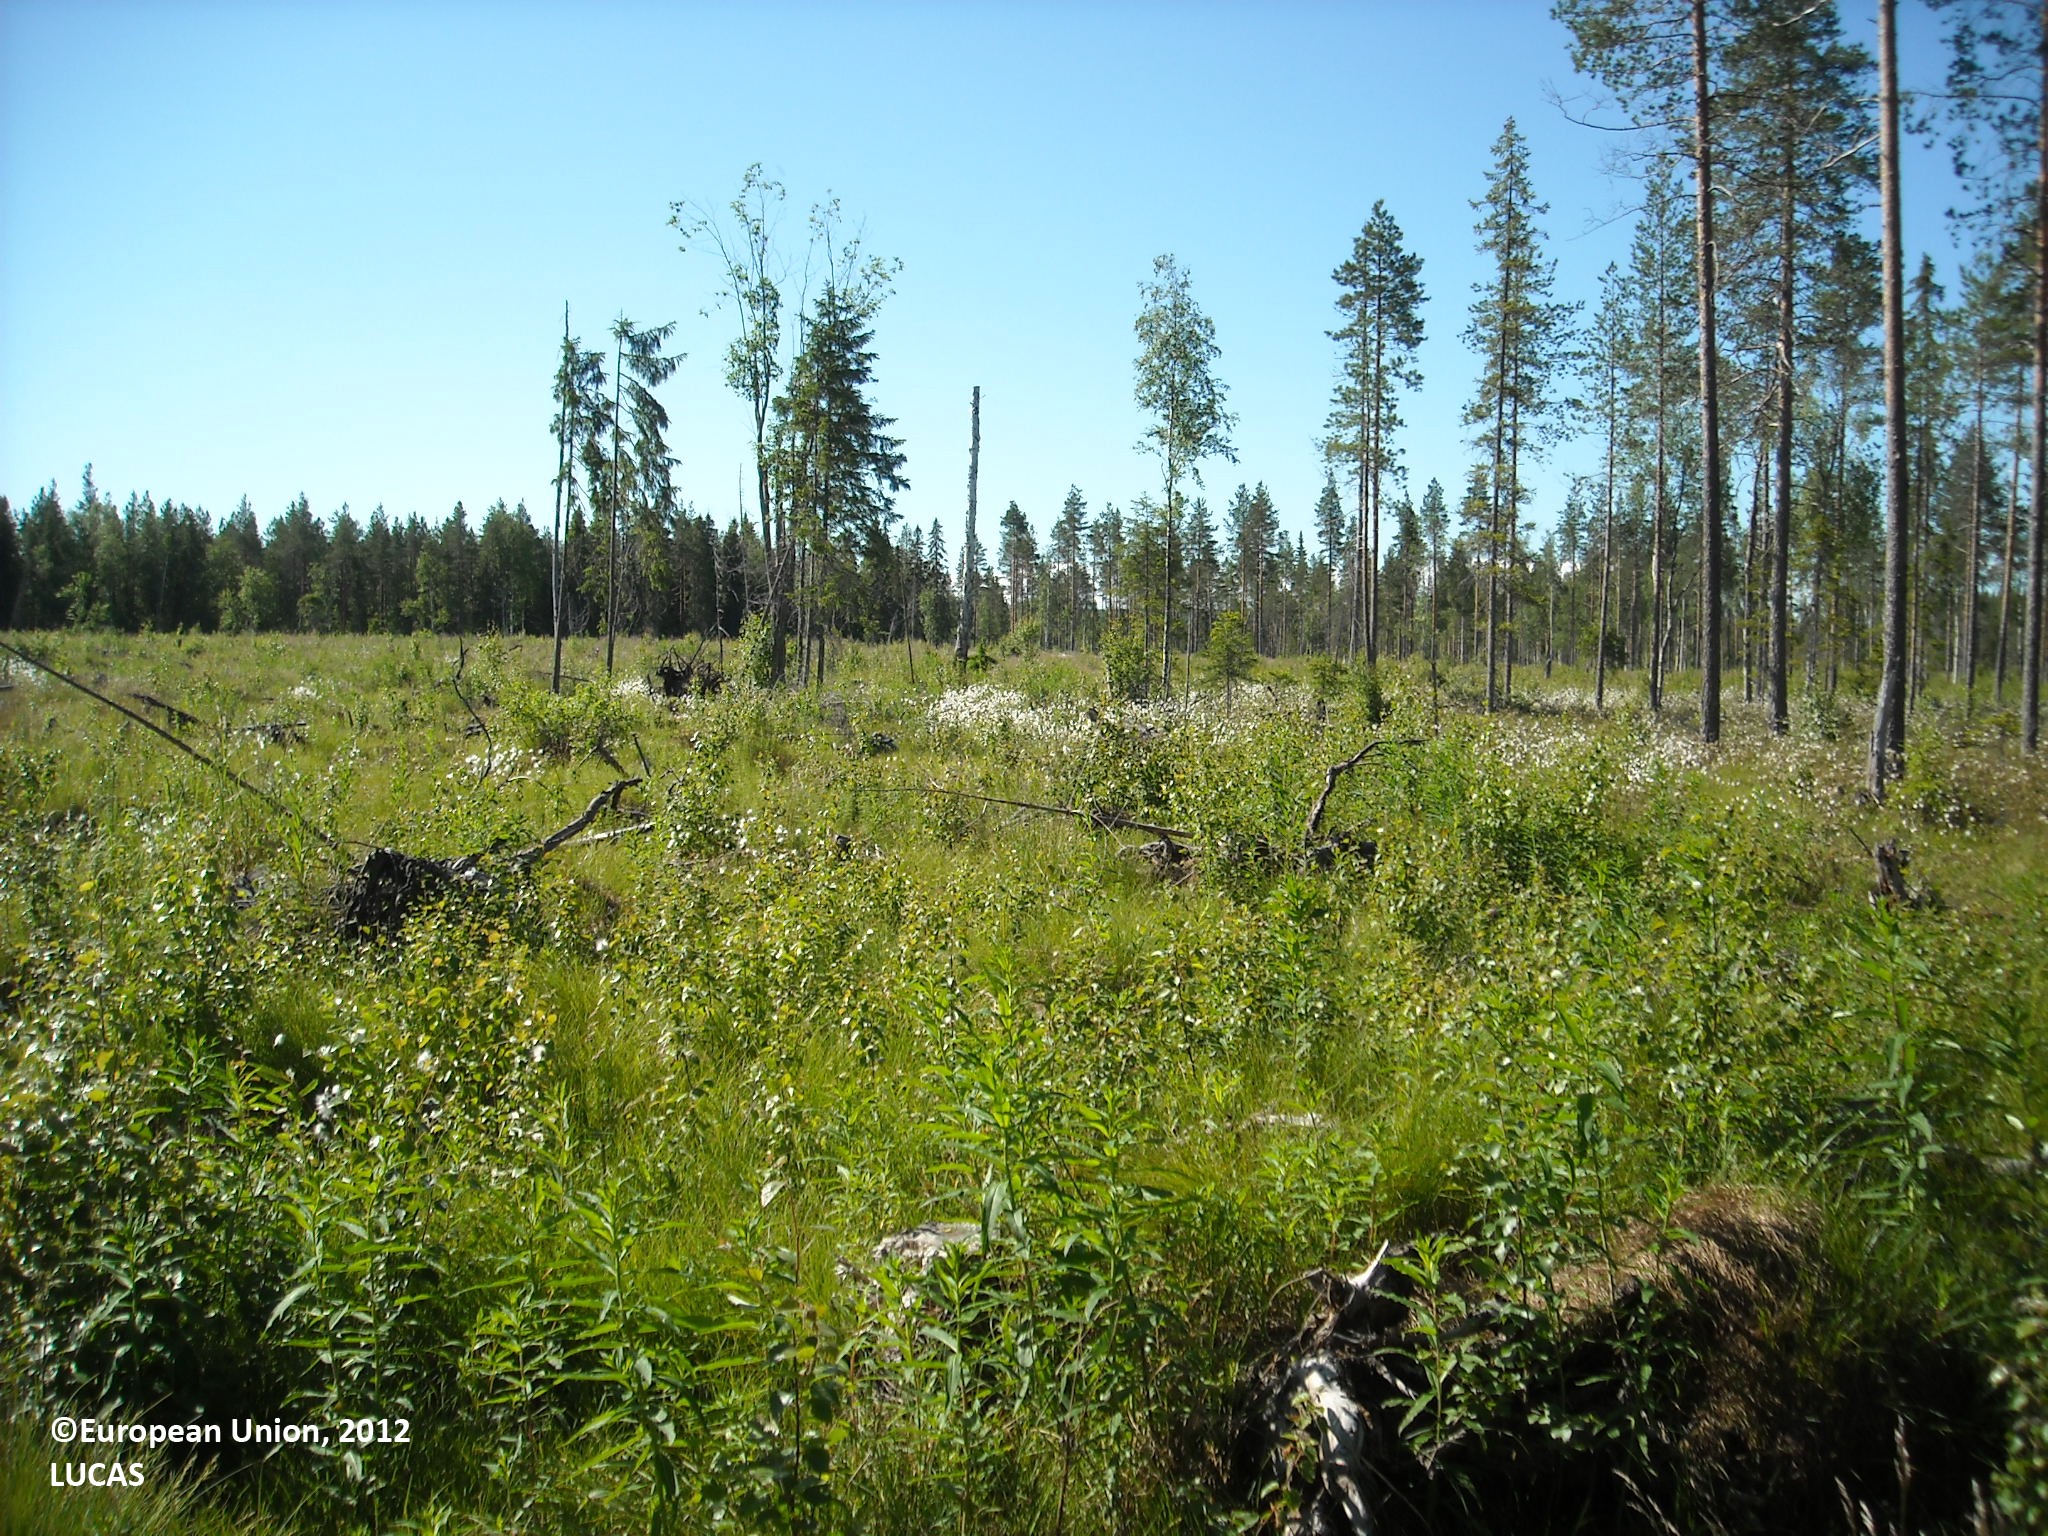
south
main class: Woodland
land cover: Pine dominated coniferous woodland
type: boreal forest
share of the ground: 25 - 50 %
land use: Forestry
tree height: > 5 m
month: July
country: FI
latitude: 64.9215
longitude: 27.4971
